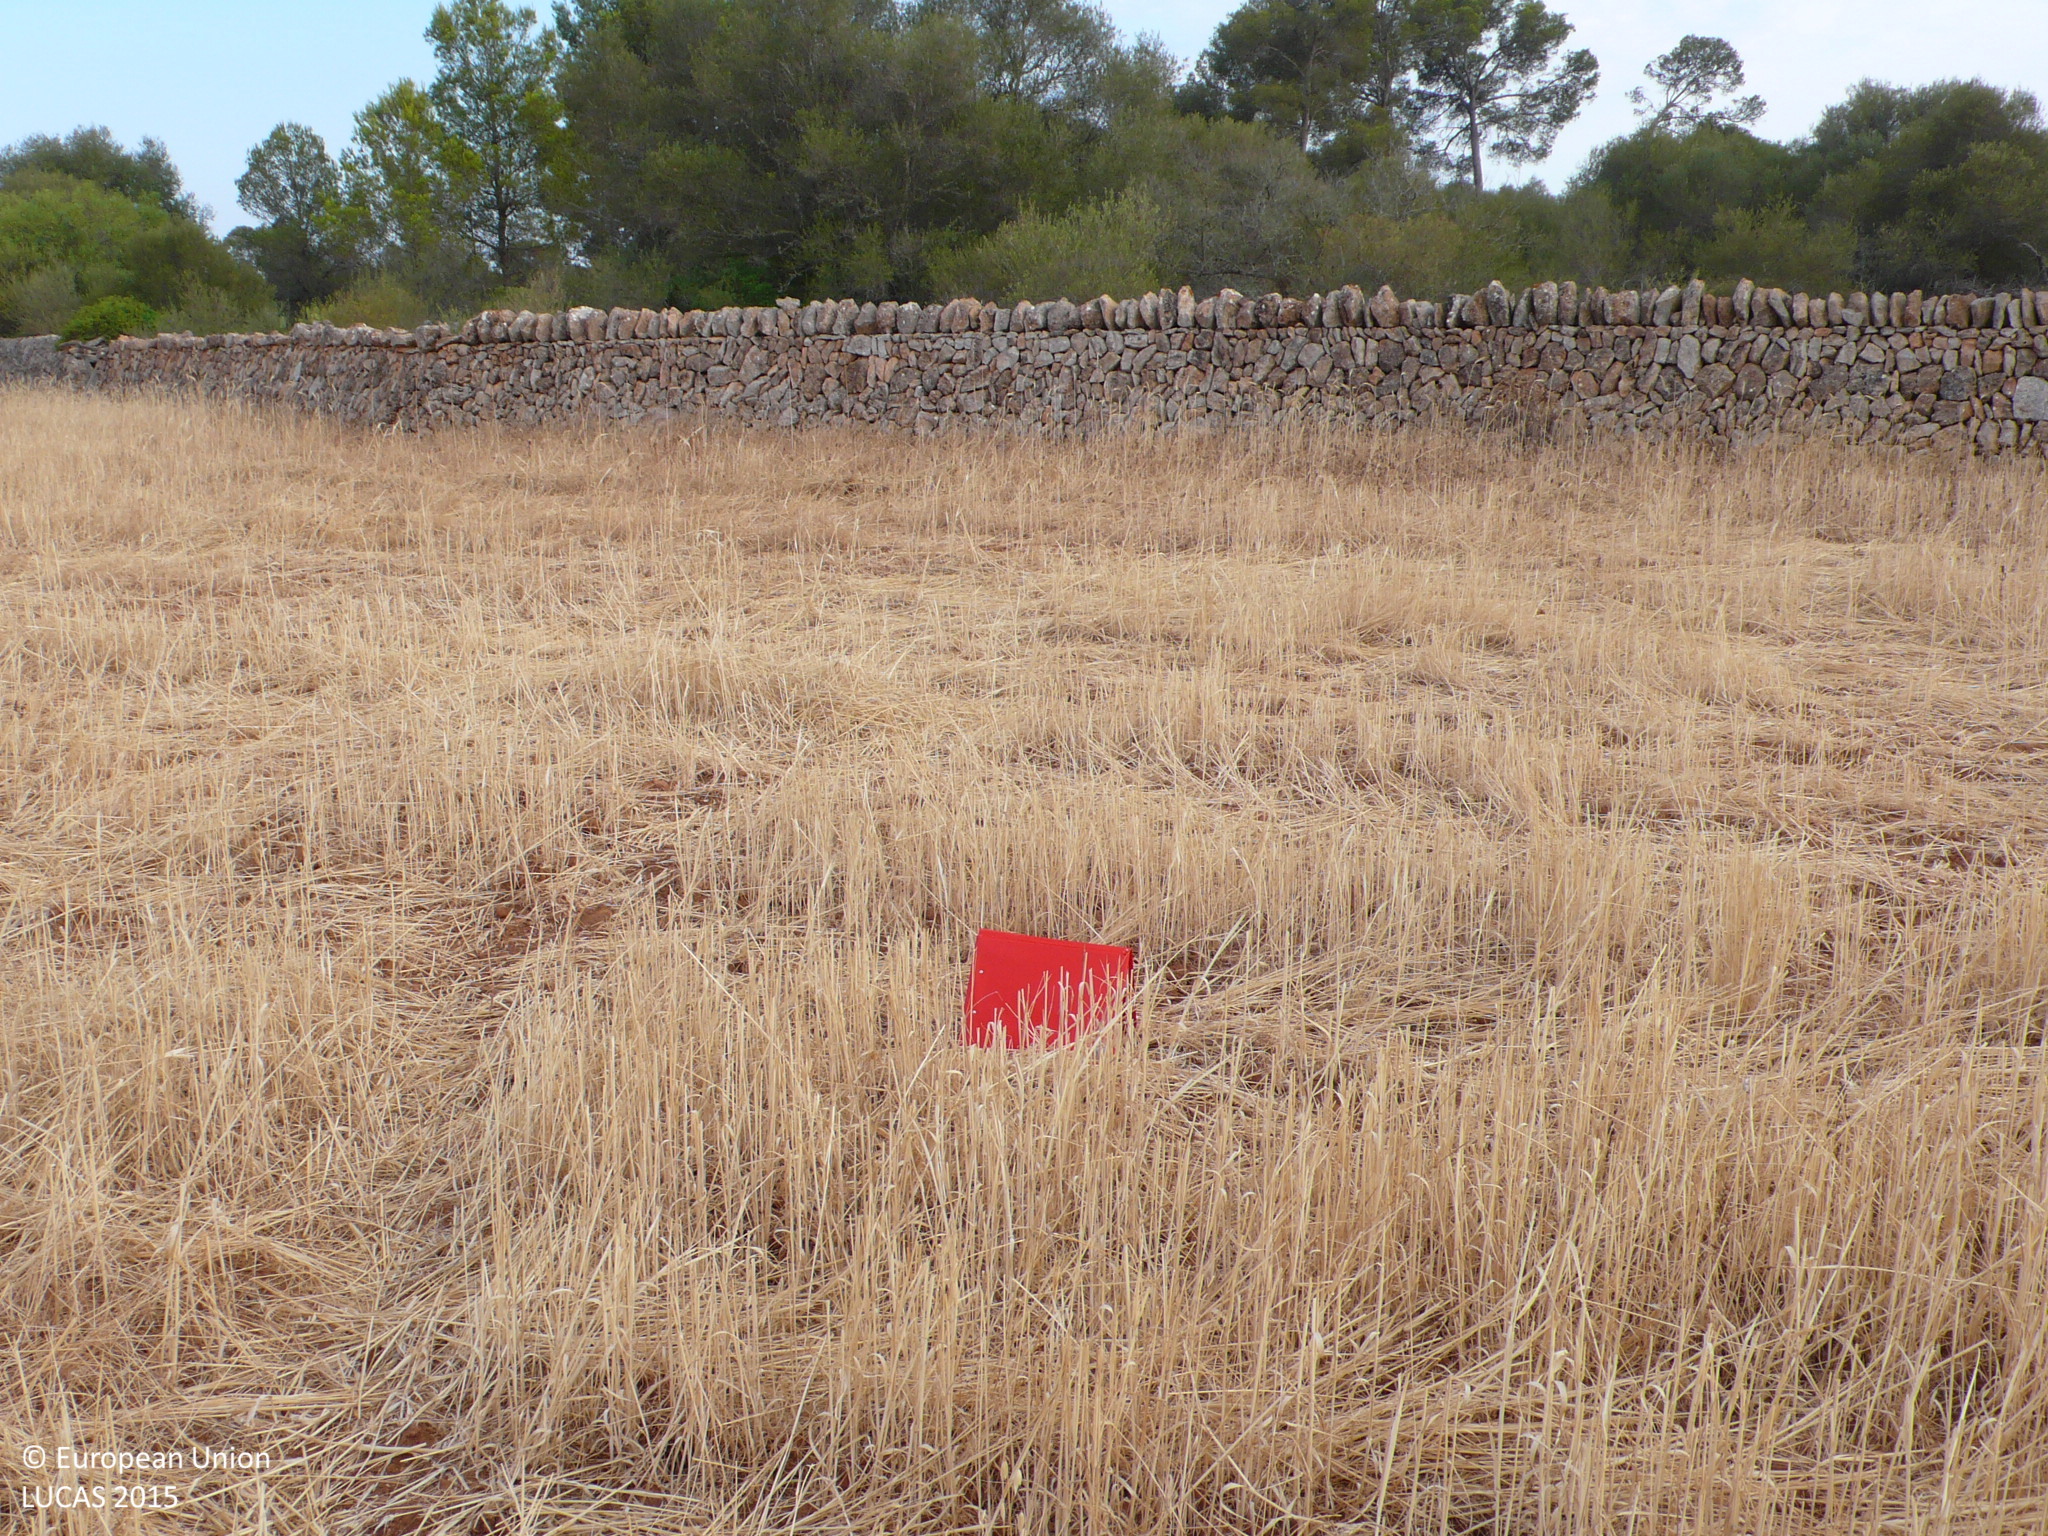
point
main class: Cropland
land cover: Common wheat
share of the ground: < 10 %
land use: Agriculture (excluding fallow land and kitchen gardens)
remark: Harvested field
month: July
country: ES
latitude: 39.4765
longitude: 2.8119
